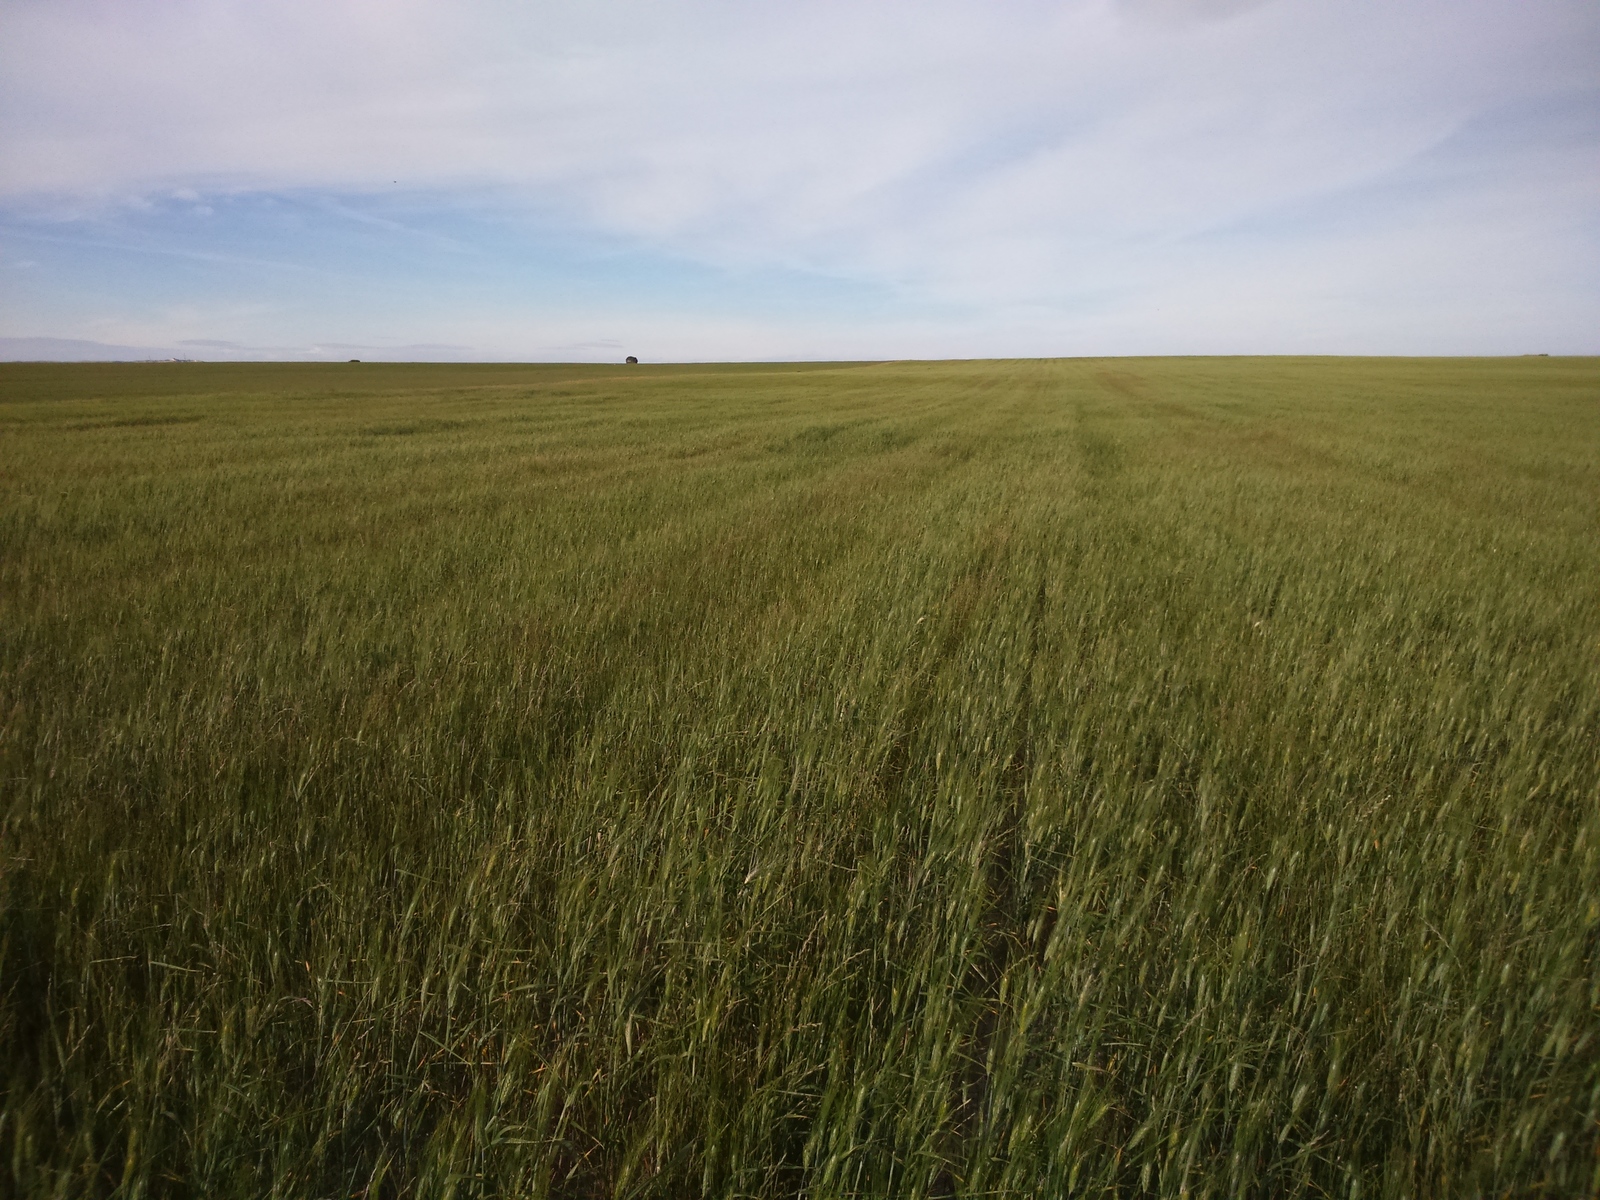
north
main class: Cropland
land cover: Durum wheat
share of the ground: > 75 %
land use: Agriculture (excluding fallow land and kitchen gardens)
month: April
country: ES
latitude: 41.4592
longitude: -0.2517
